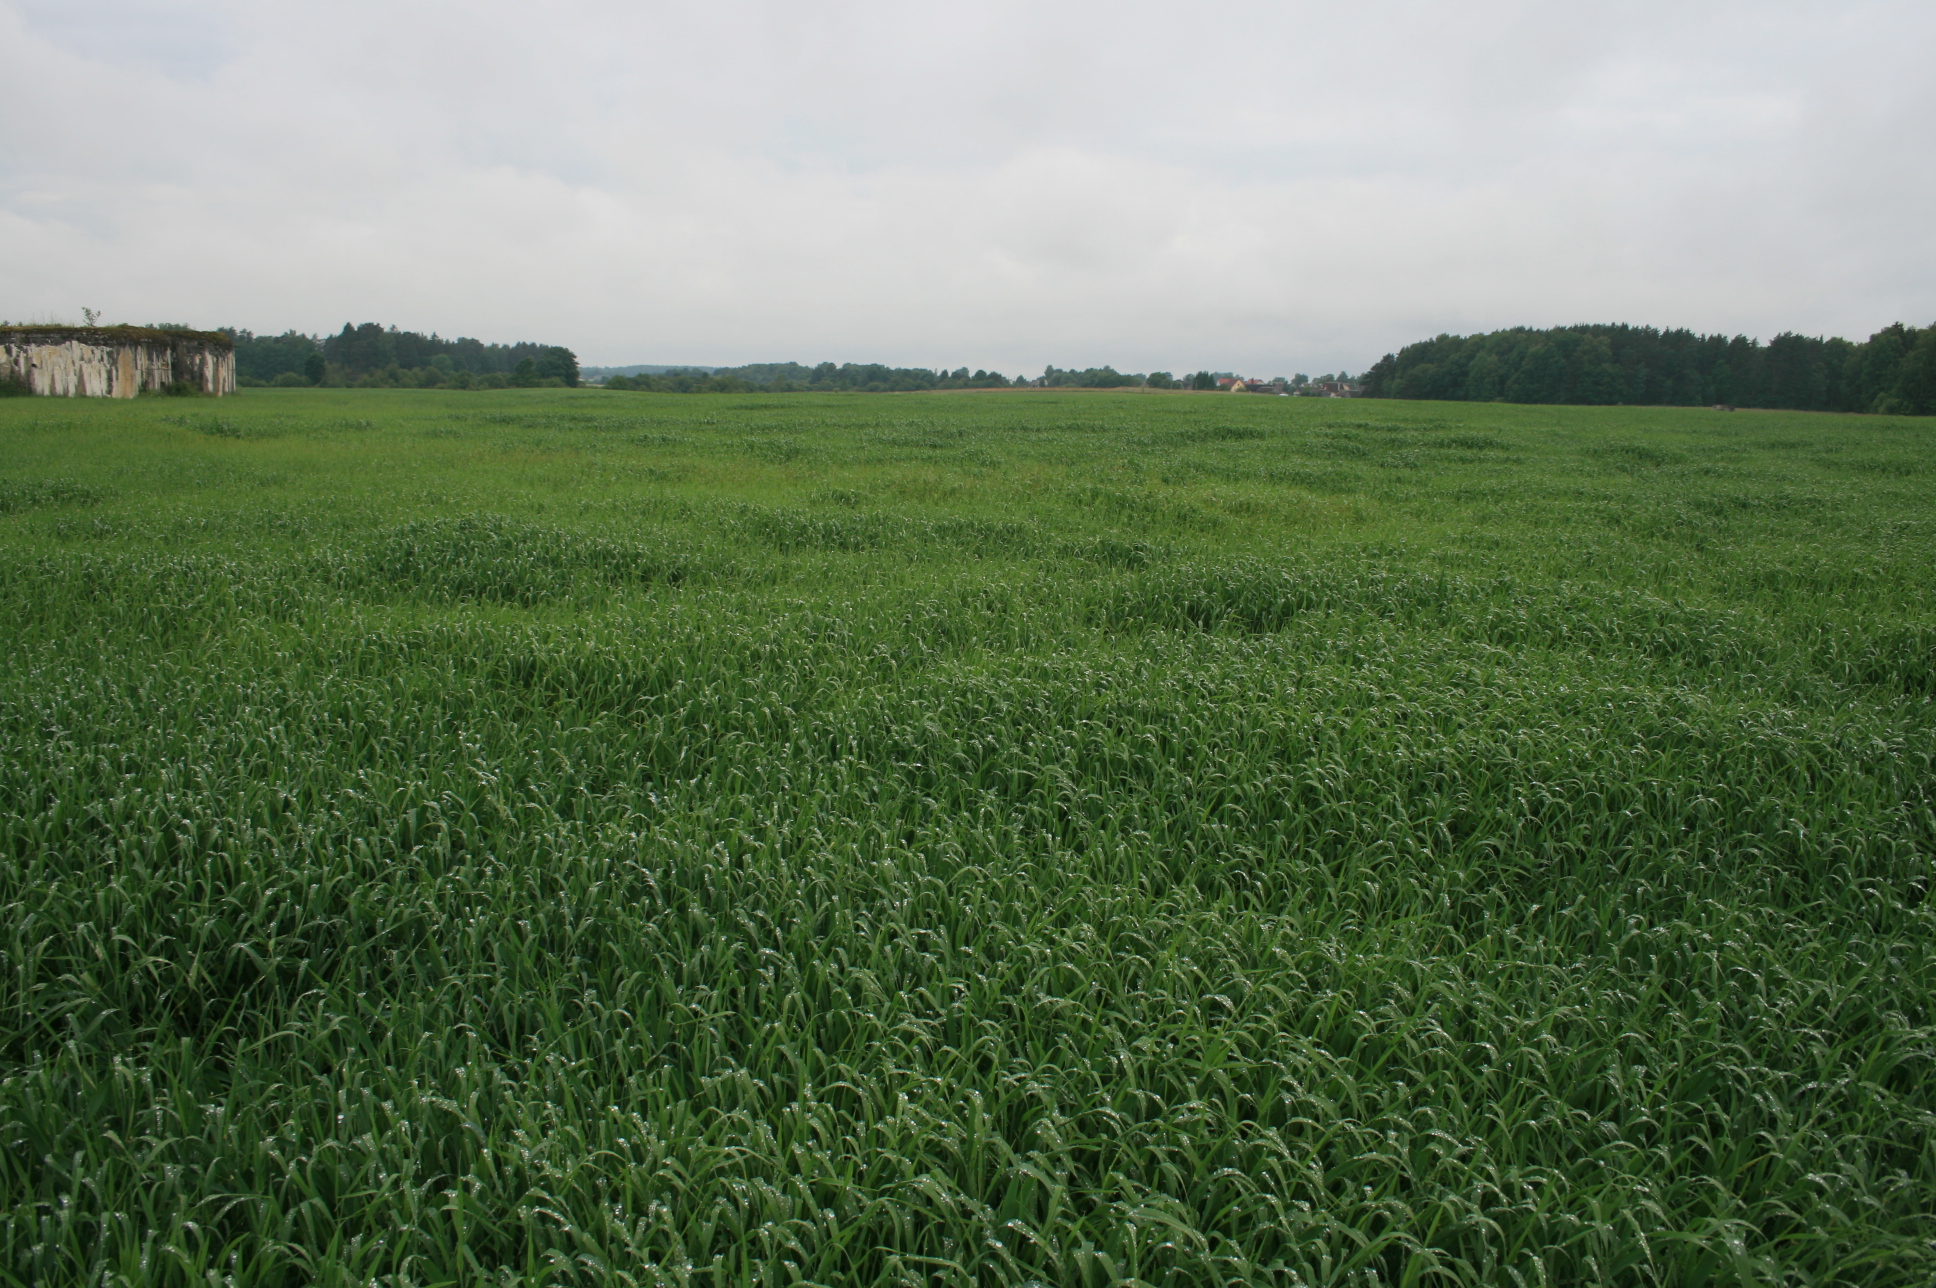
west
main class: Cropland
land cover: Barley
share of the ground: > 75 %
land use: Agriculture (excluding fallow land and kitchen gardens)
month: June
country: LT
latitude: 55.2514
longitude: 22.4416
